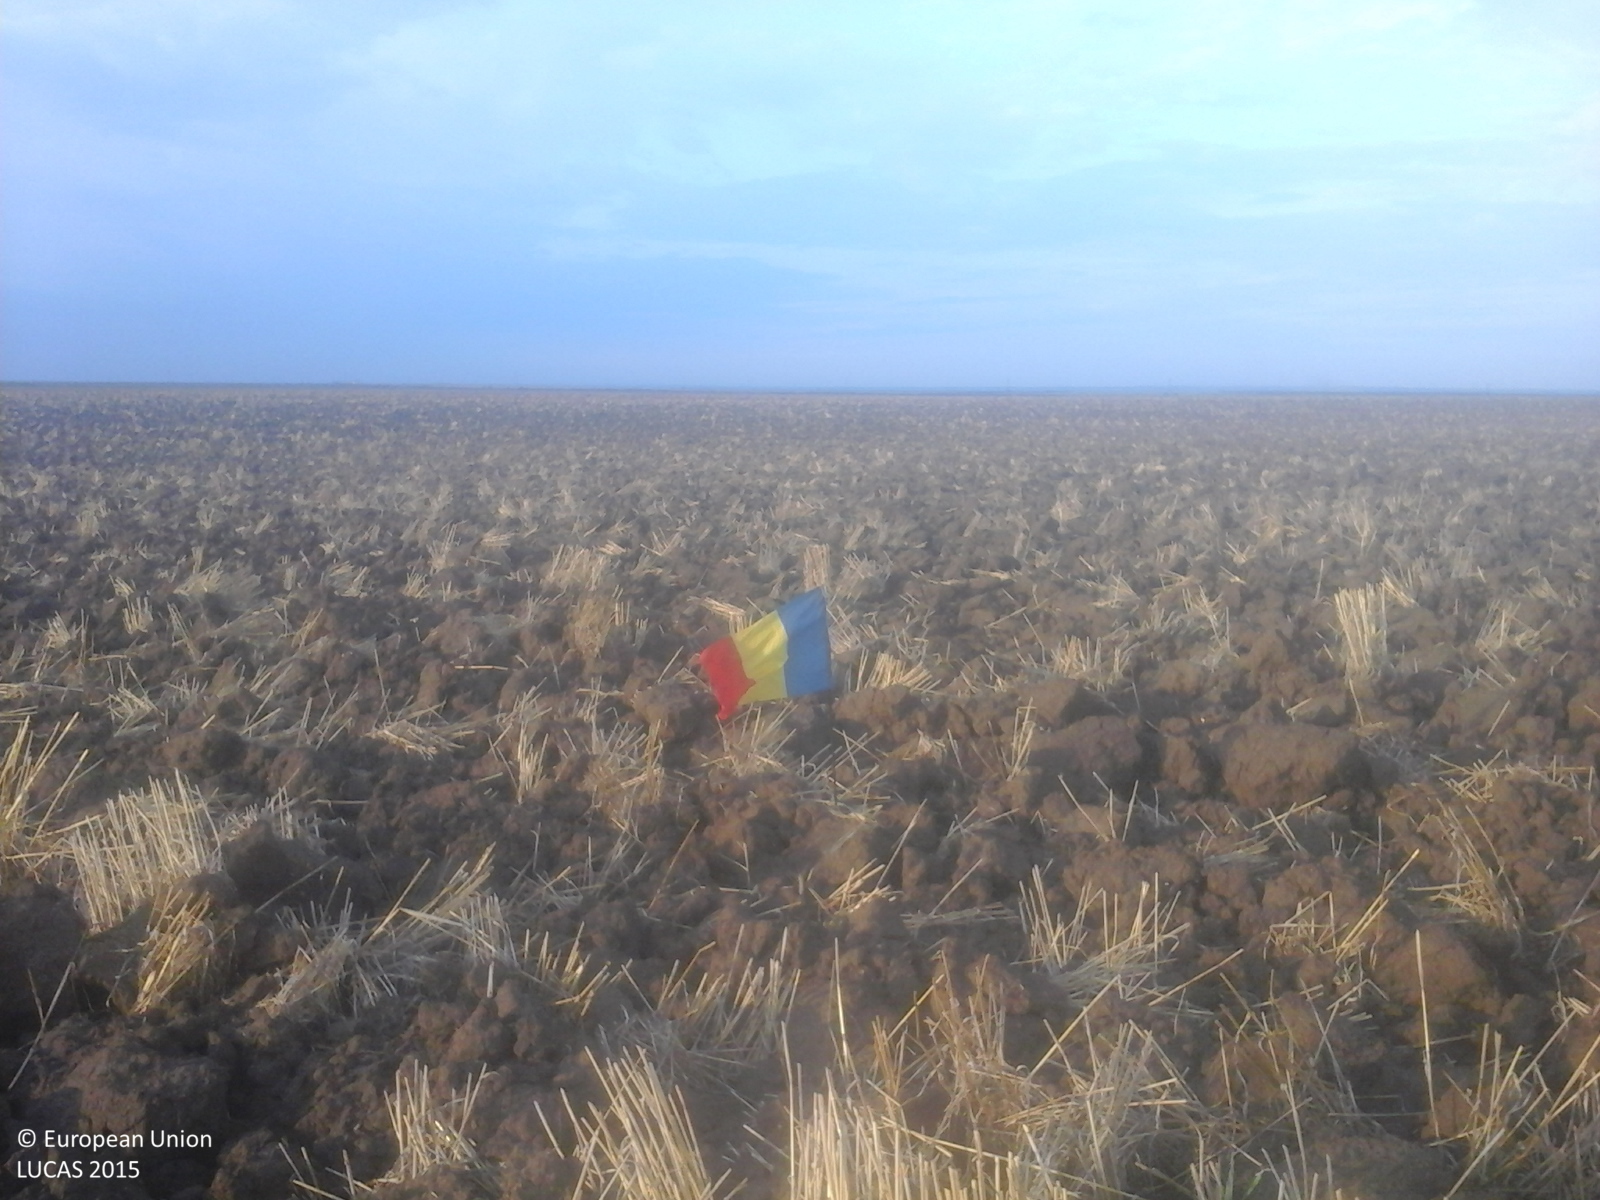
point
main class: Cropland
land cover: Common wheat
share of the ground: < 10 %
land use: Agriculture (excluding fallow land and kitchen gardens)
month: July
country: RO
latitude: 43.8341
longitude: 24.5288
